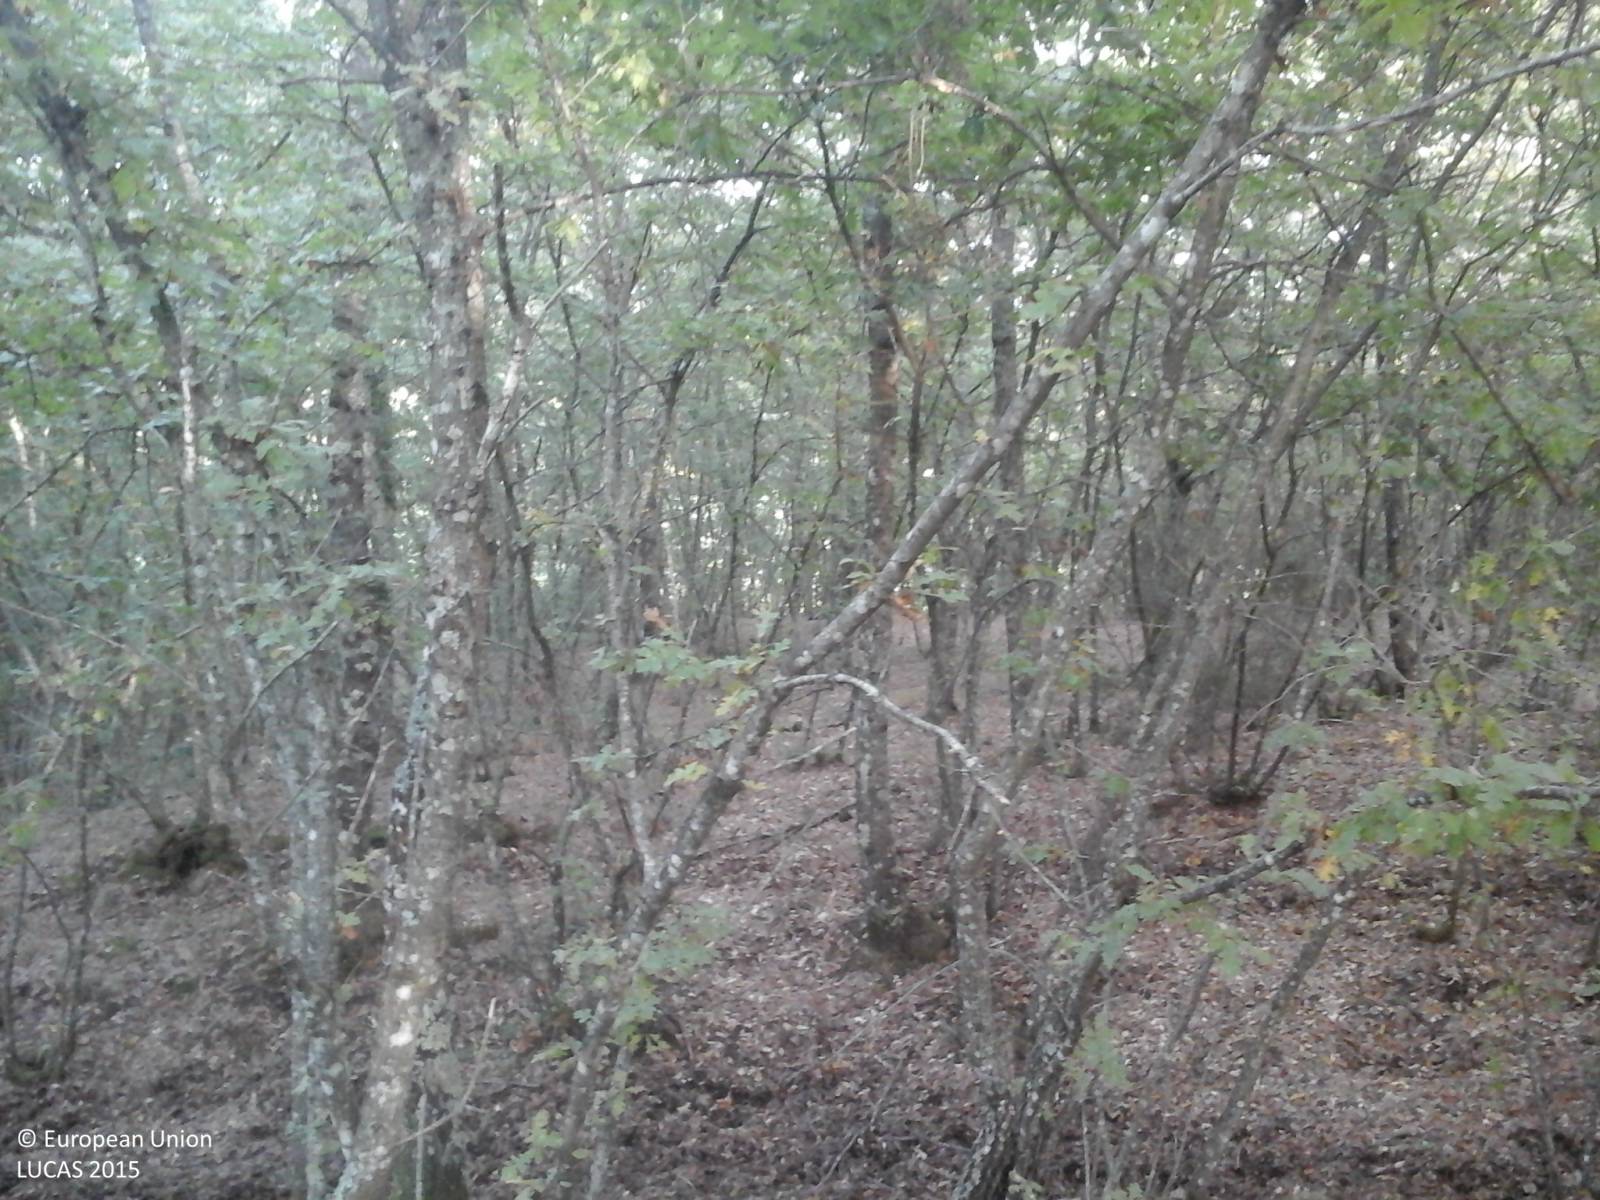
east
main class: Woodland
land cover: Broadleaved woodland
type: thermophilous deciduous forest
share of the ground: > 75 %
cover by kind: broadleaved forest trees 100 %
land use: Forestry
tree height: > 5 m
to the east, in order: Broadleaved woodland; Spontaneously vegetated surfaces
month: October
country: IT
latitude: 42.7915
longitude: 12.2546
